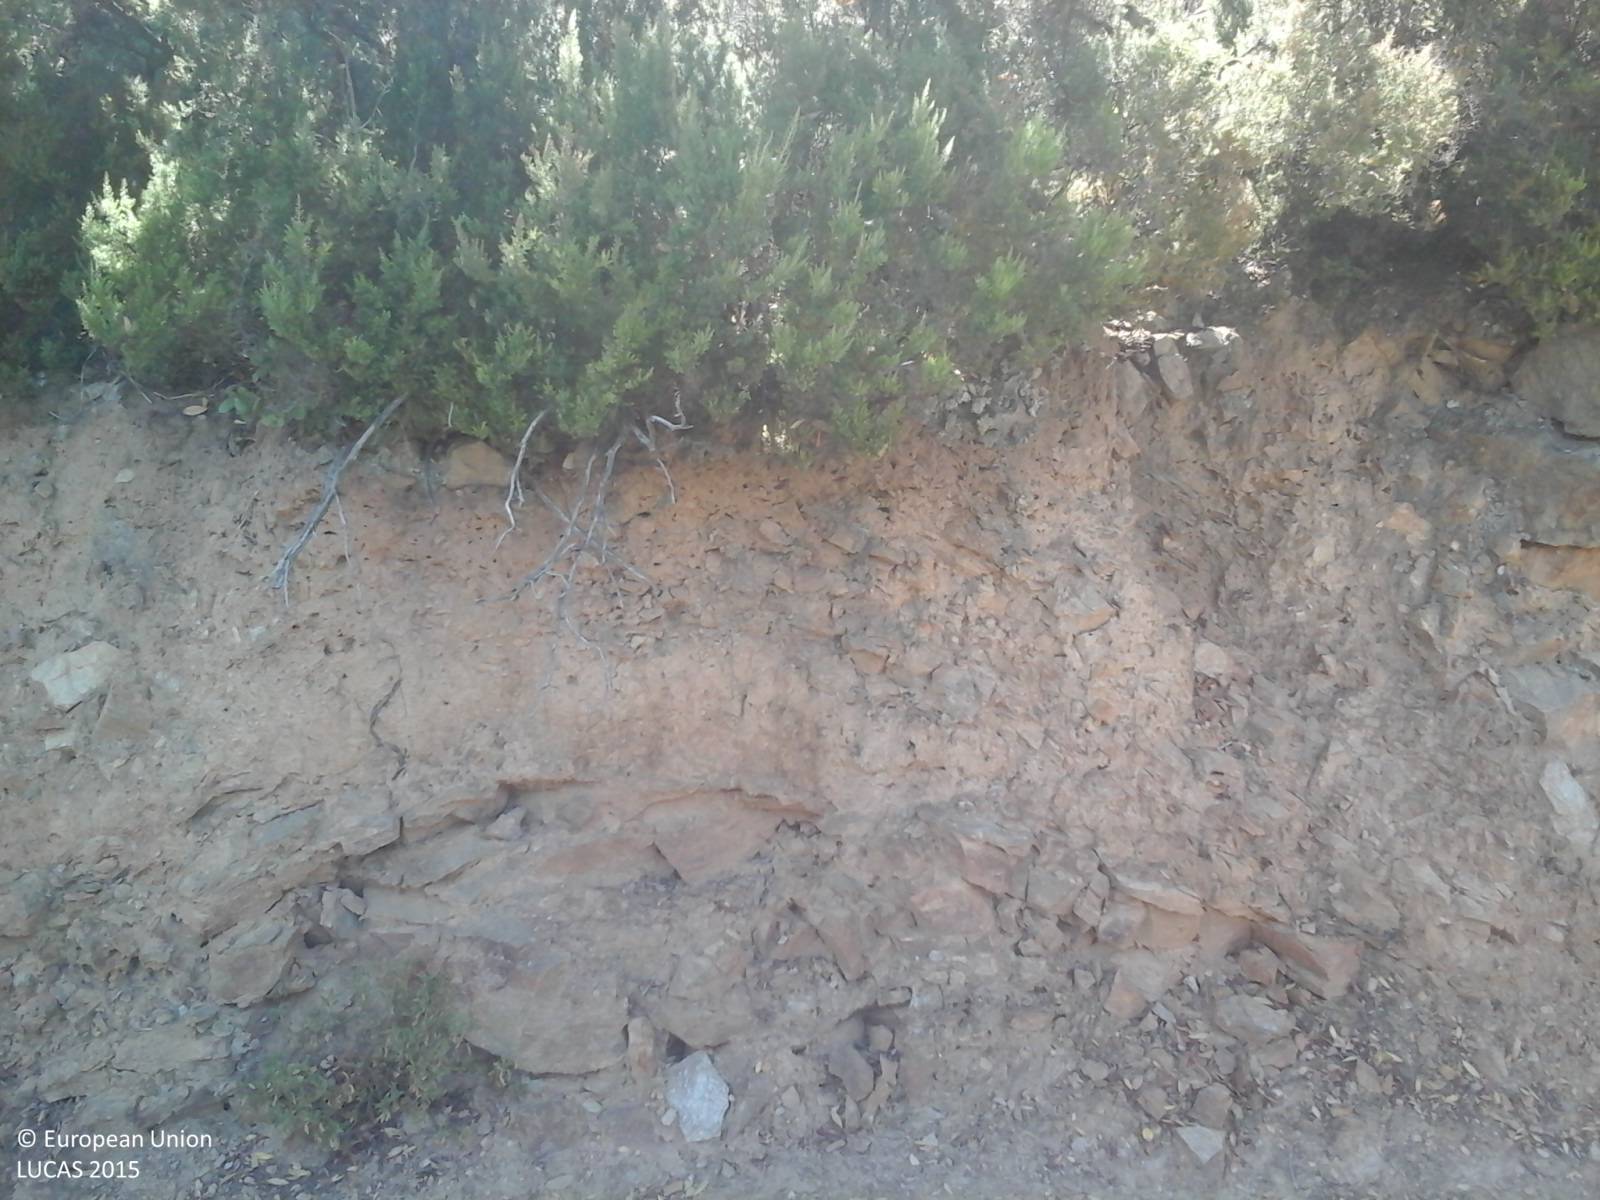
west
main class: Woodland
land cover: Broadleaved woodland
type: broadleaved evergreen forest
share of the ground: > 75 %
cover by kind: broadleaved forest trees 95 %, shrubs 5 %
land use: Semi-natural and natural areas not in use
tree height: > 5 m
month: June
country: IT
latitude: 40.5380
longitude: 9.5888
